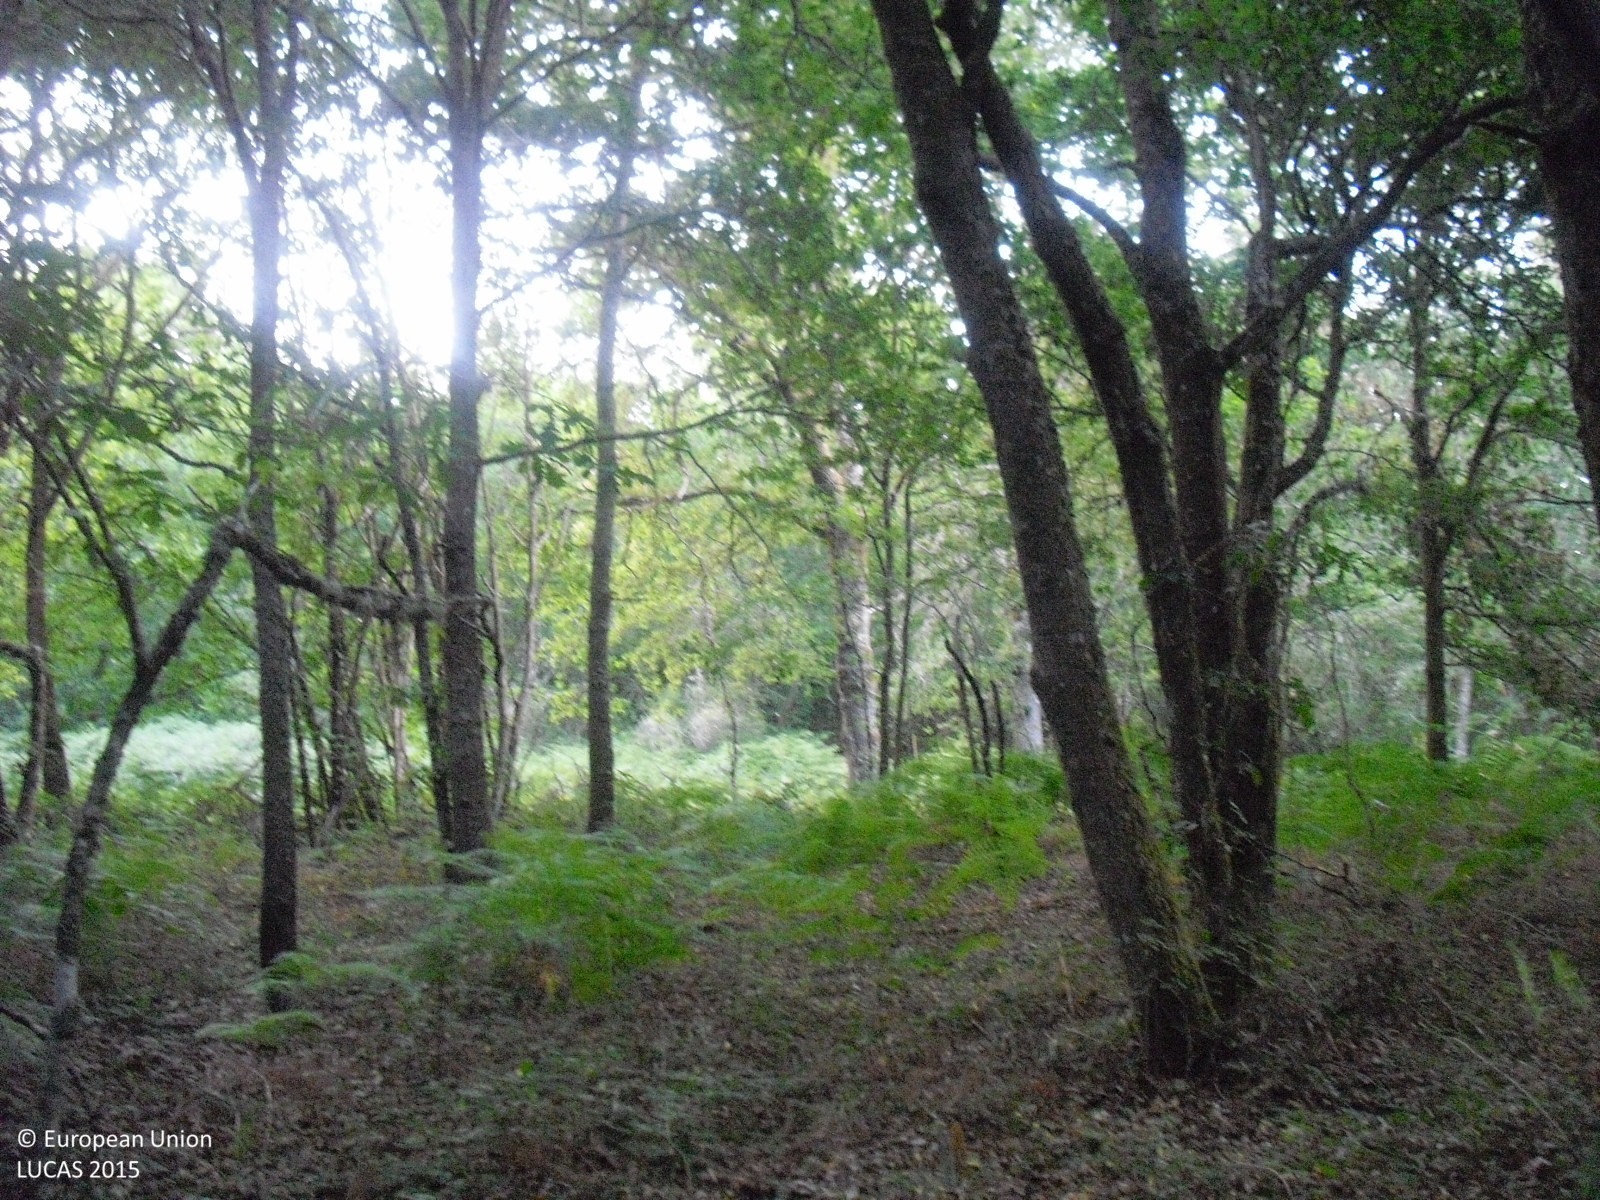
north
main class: Woodland
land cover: Broadleaved woodland
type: acidophilous oak and oak-birch forest
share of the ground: > 75 %
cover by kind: broadleaved forest trees 70 %, shrubs 30 %
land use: Forestry
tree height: > 5 m
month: July
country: ES
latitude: 42.3292
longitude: -7.7304
